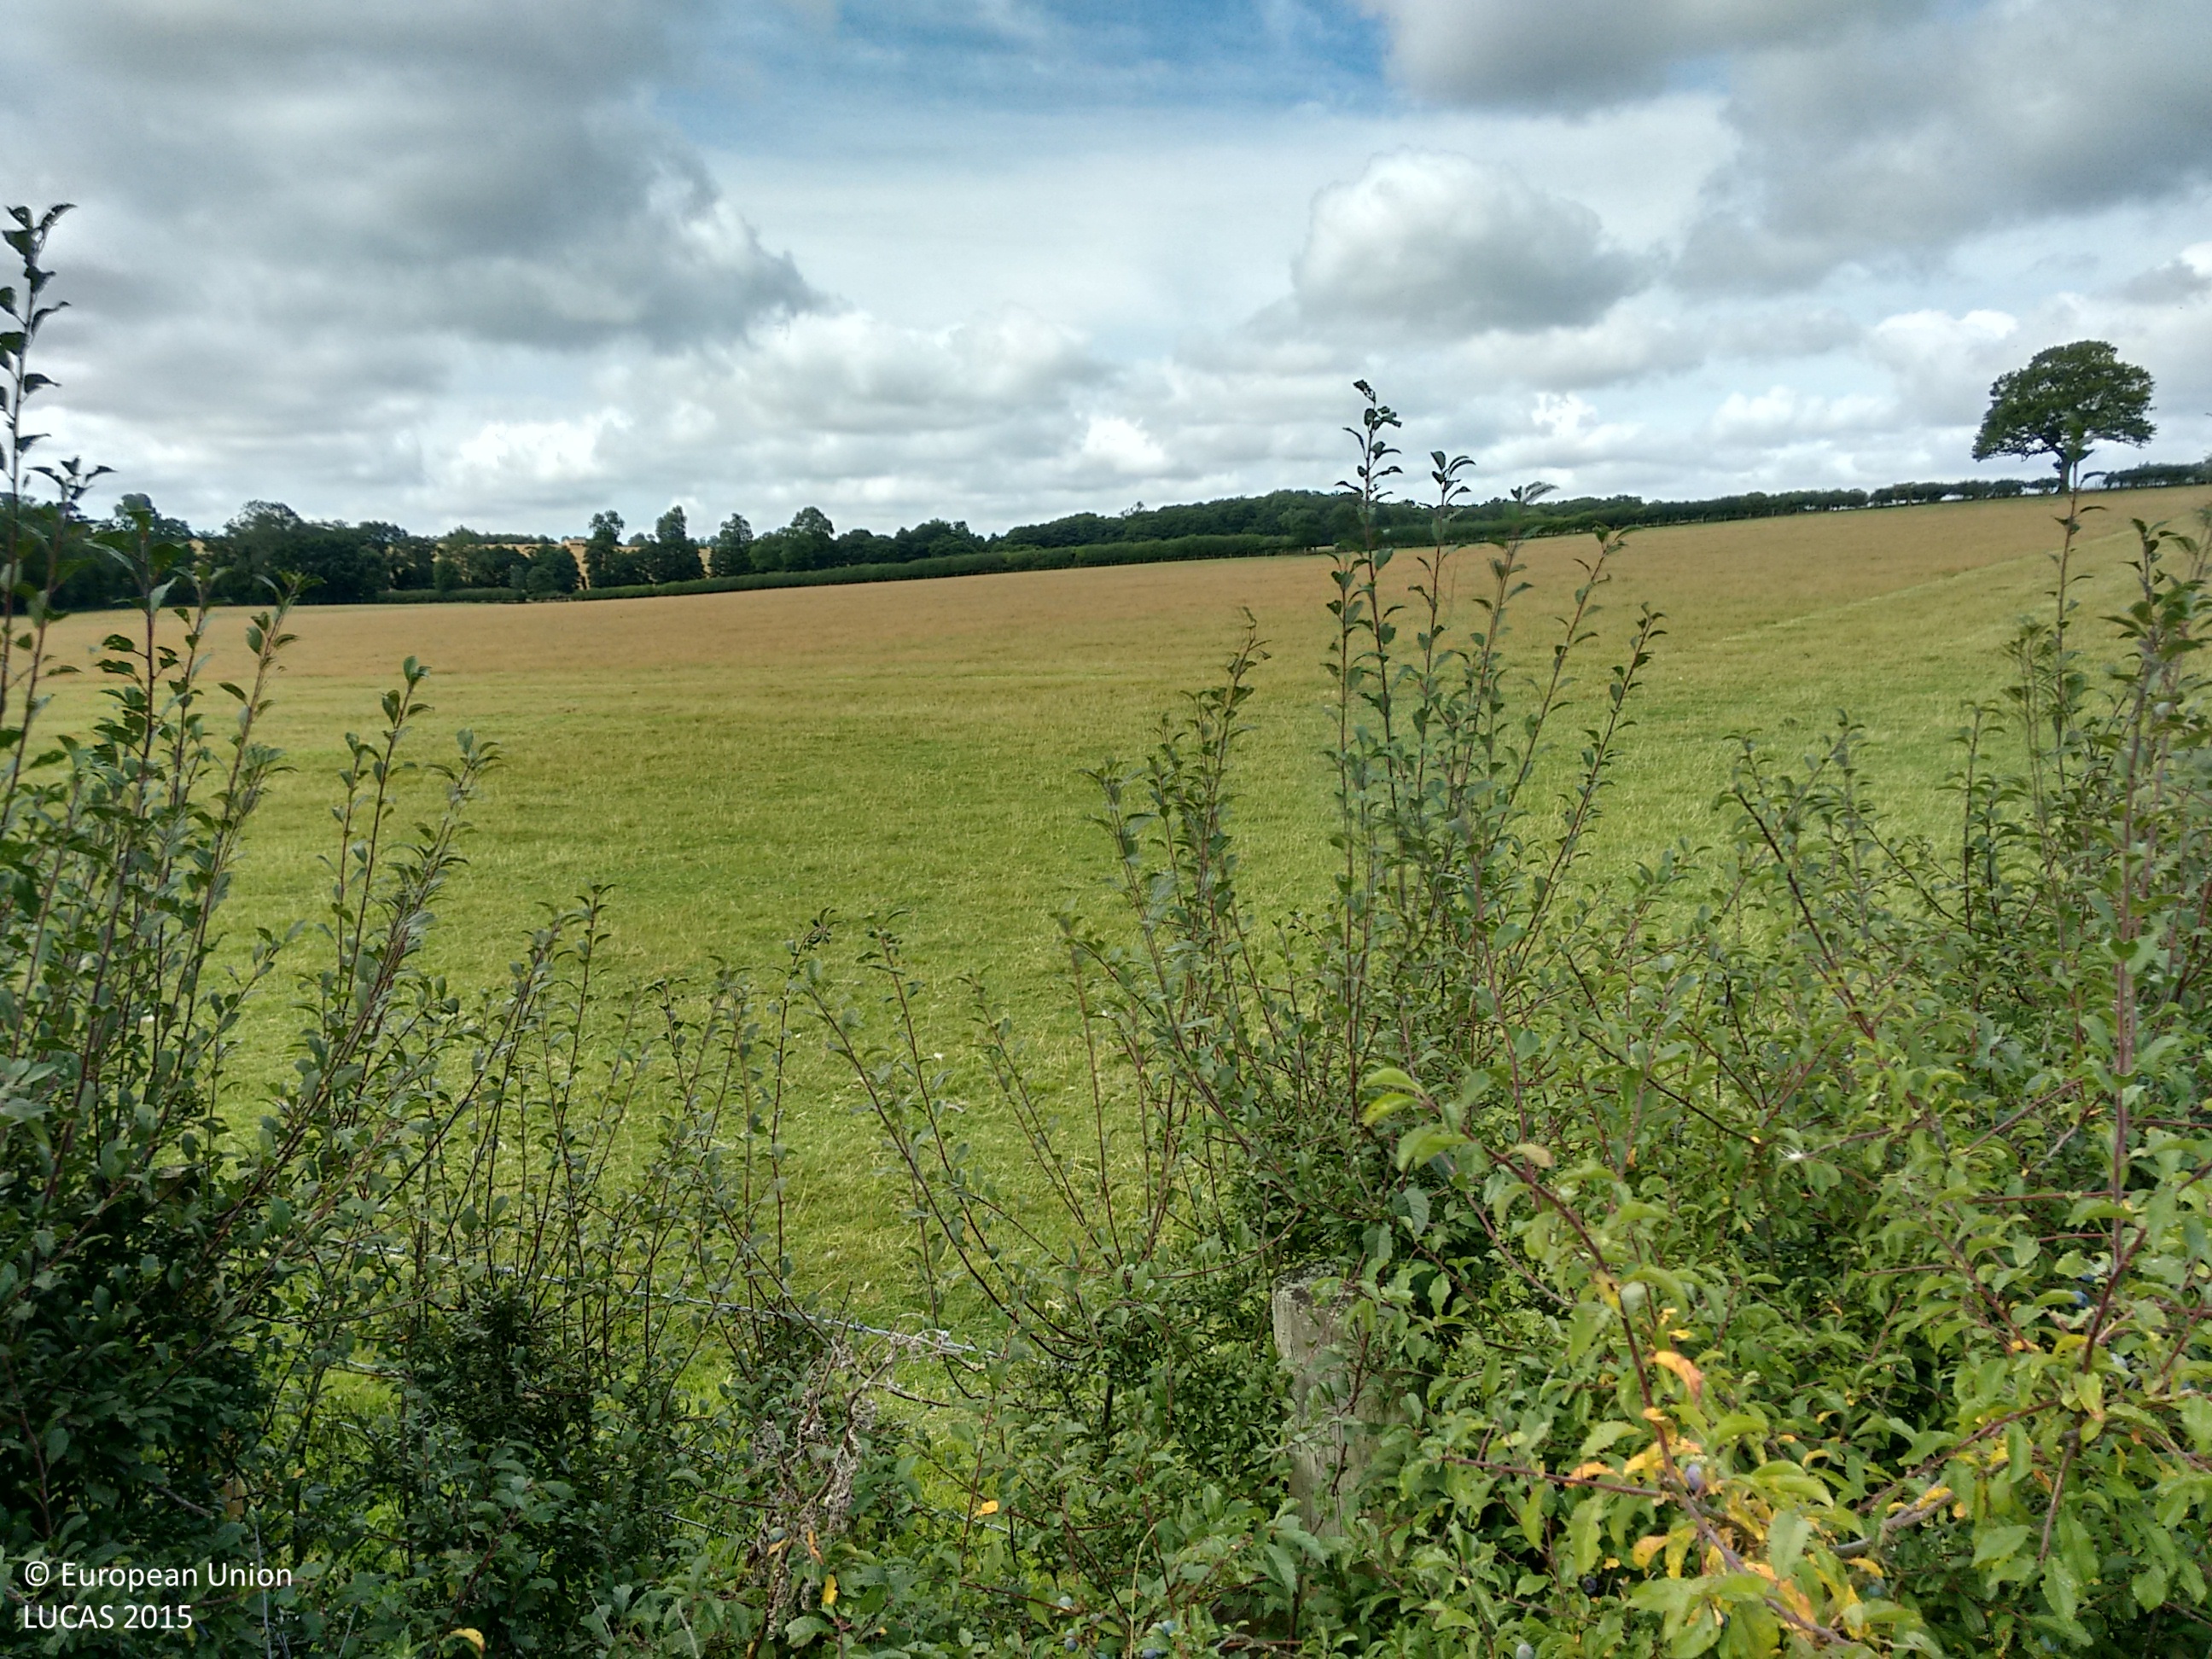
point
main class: Grassland
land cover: Grassland without tree/shrub cover
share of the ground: > 75 %
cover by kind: herbaceous plants 100 %
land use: Agriculture (excluding fallow land and kitchen gardens)
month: August
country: GB
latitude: 52.3221
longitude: -1.1526
